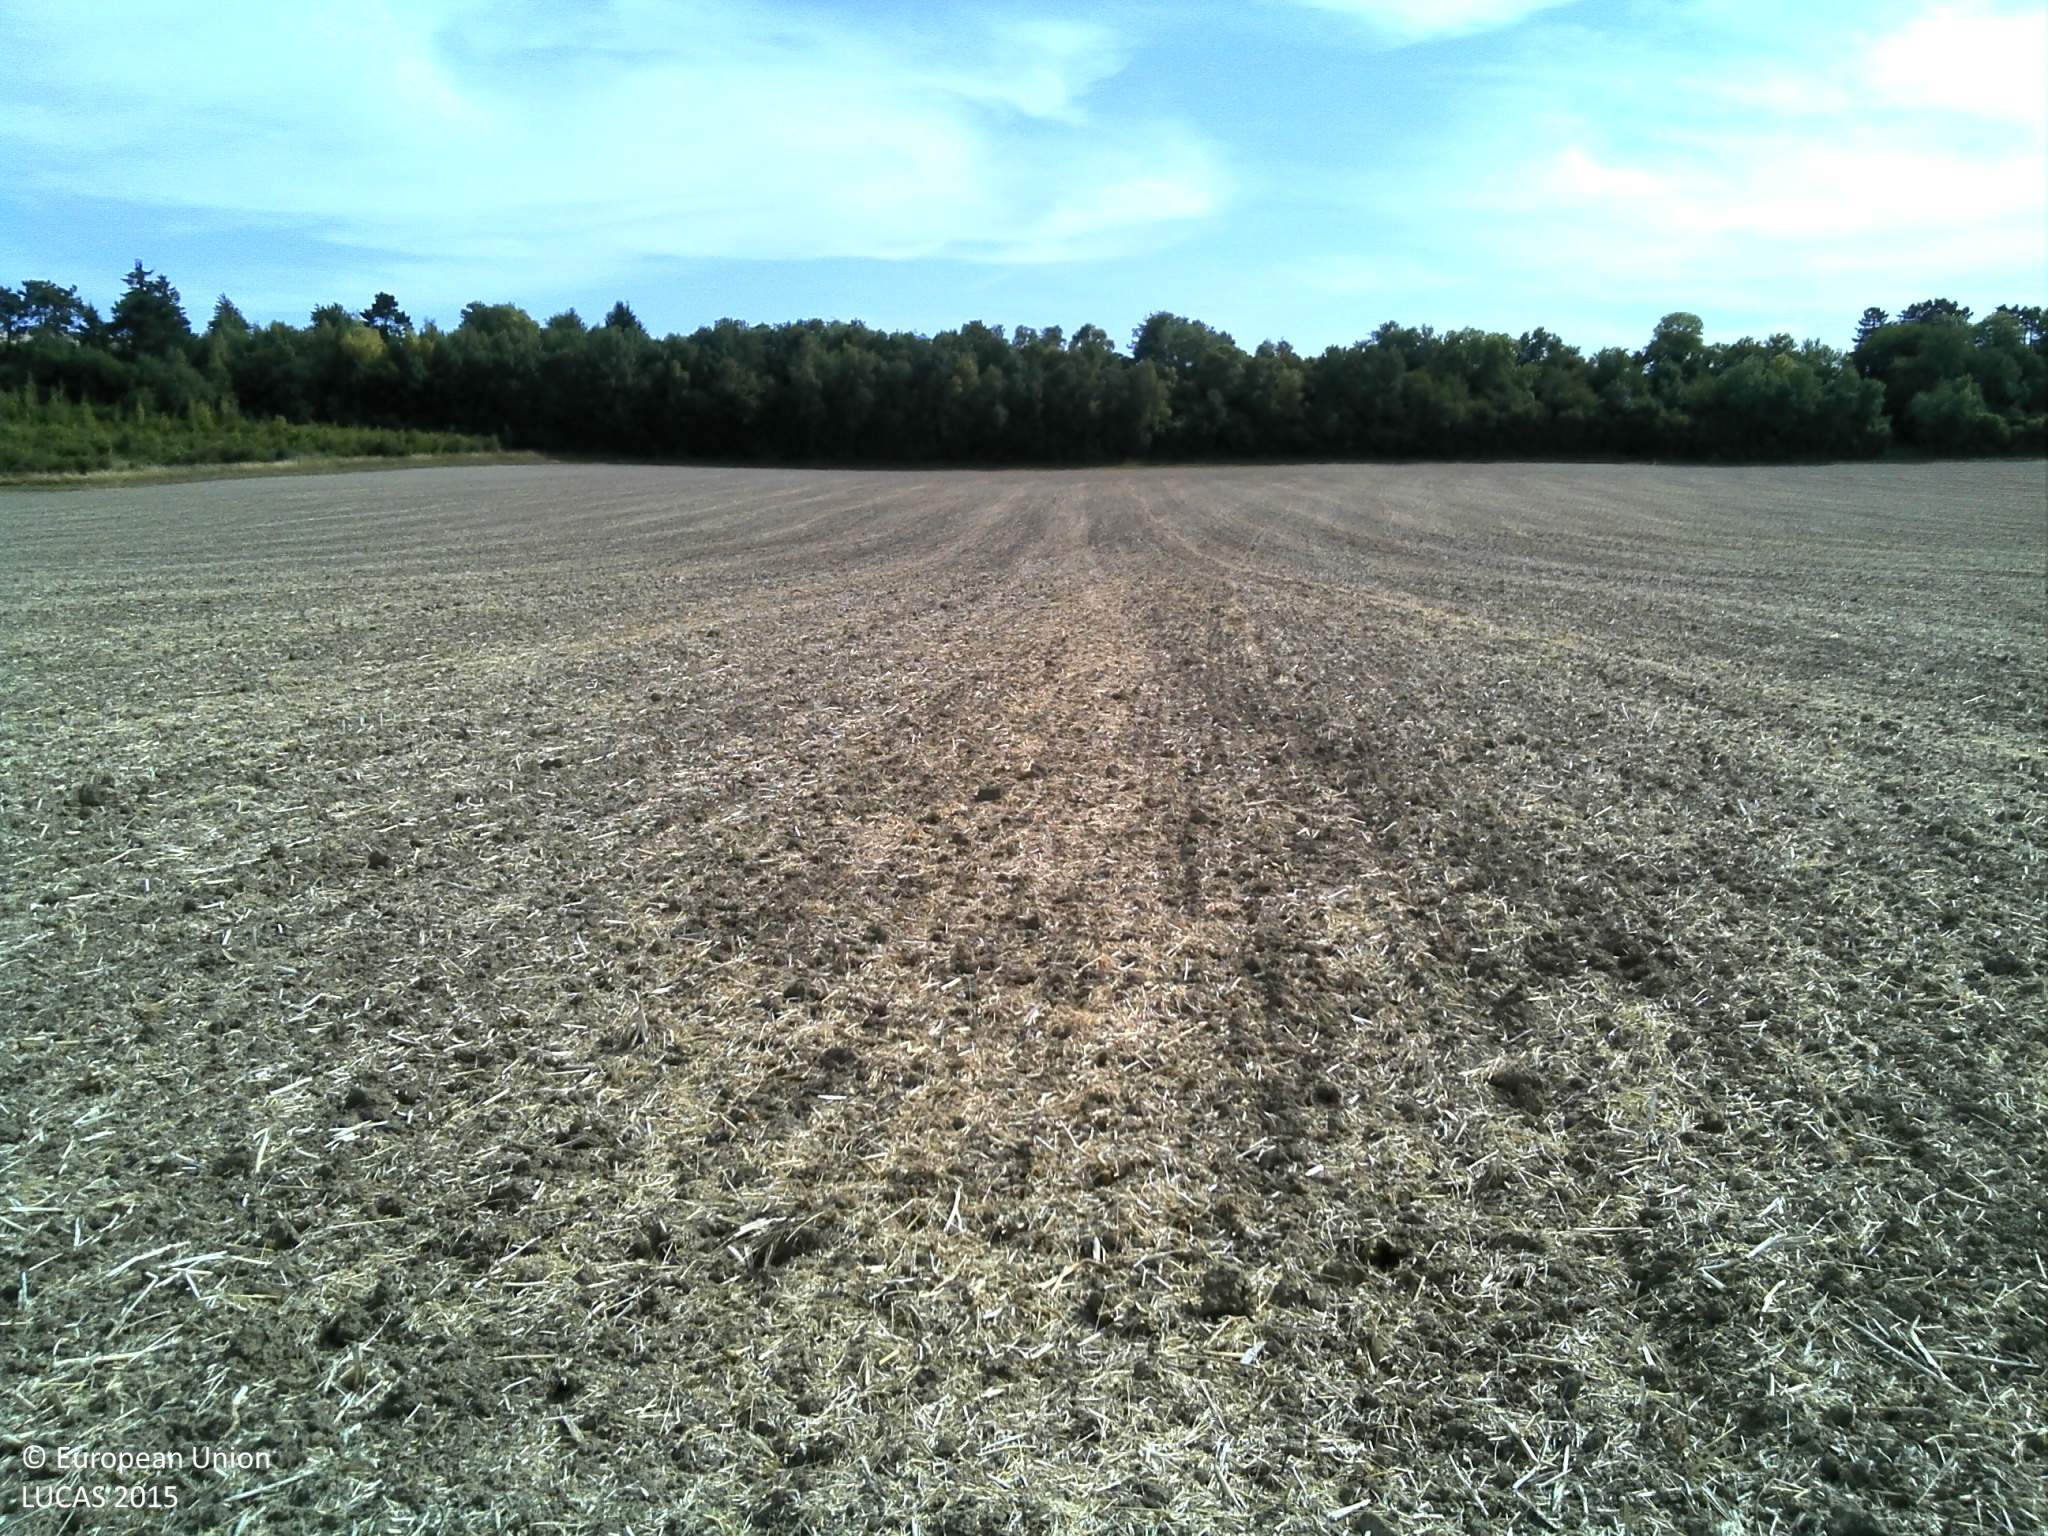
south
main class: Cropland
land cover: Rape and turnip rape
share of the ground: > 75 %
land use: Agriculture (excluding fallow land and kitchen gardens)
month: August
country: FR
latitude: 49.0031
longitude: 4.8167
